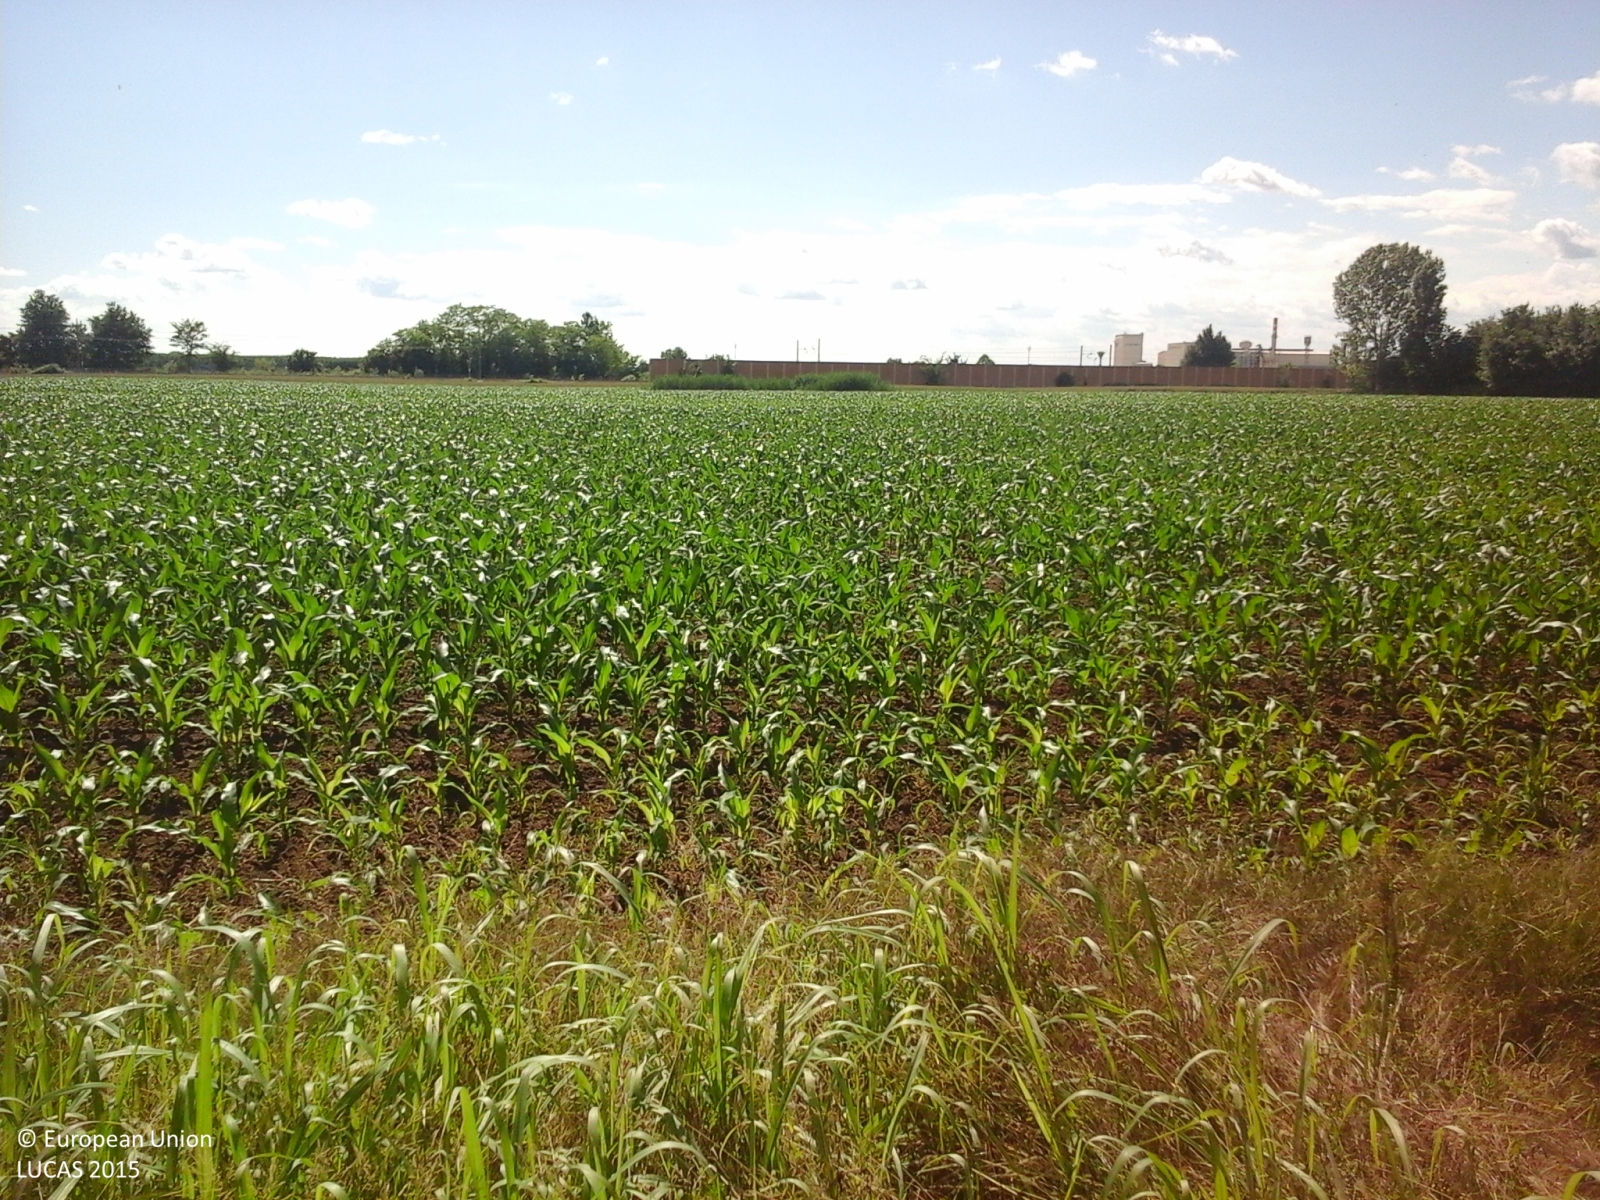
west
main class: Cropland
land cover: Common wheat
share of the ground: > 75 %
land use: Agriculture (excluding fallow land and kitchen gardens)
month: May
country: IT
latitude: 45.1381
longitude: 11.1043
